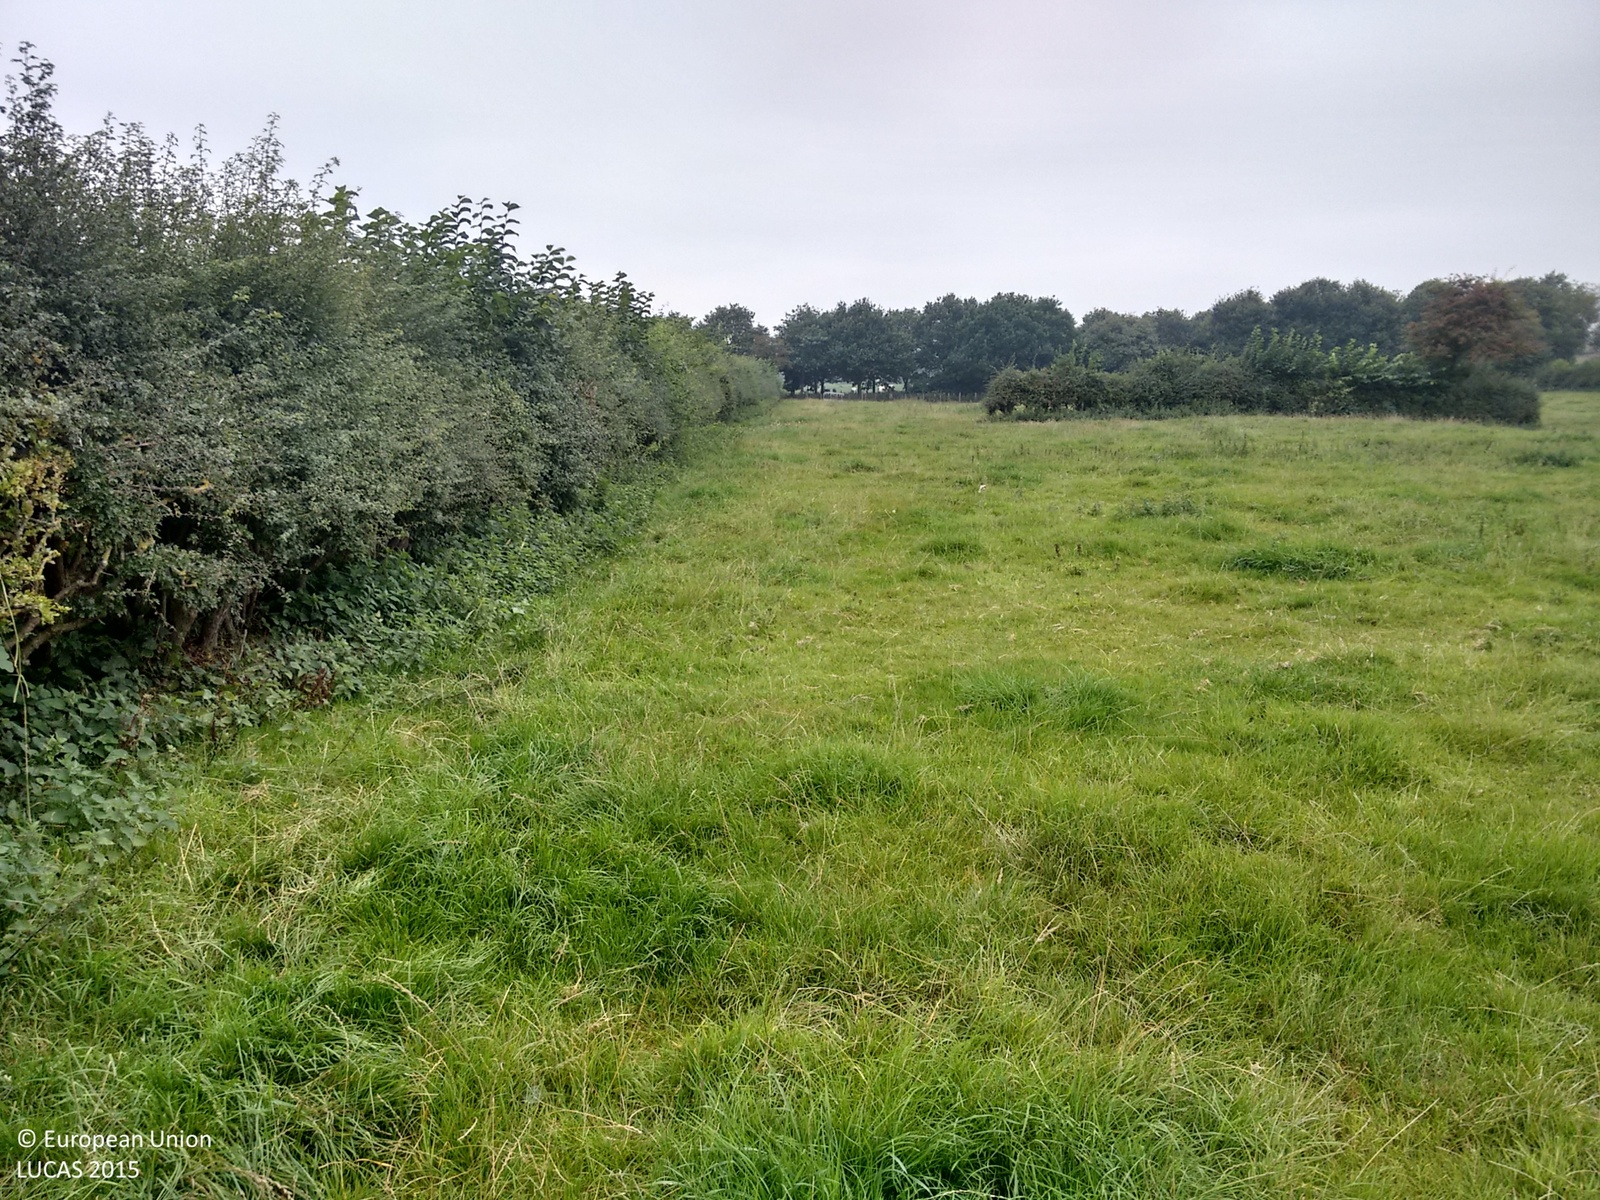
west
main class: Grassland
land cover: Grassland without tree/shrub cover
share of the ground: > 75 %
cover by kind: herbaceous plants 100 %
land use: Agriculture (excluding fallow land and kitchen gardens)
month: September
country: GB
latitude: 52.7140
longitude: -2.8470
